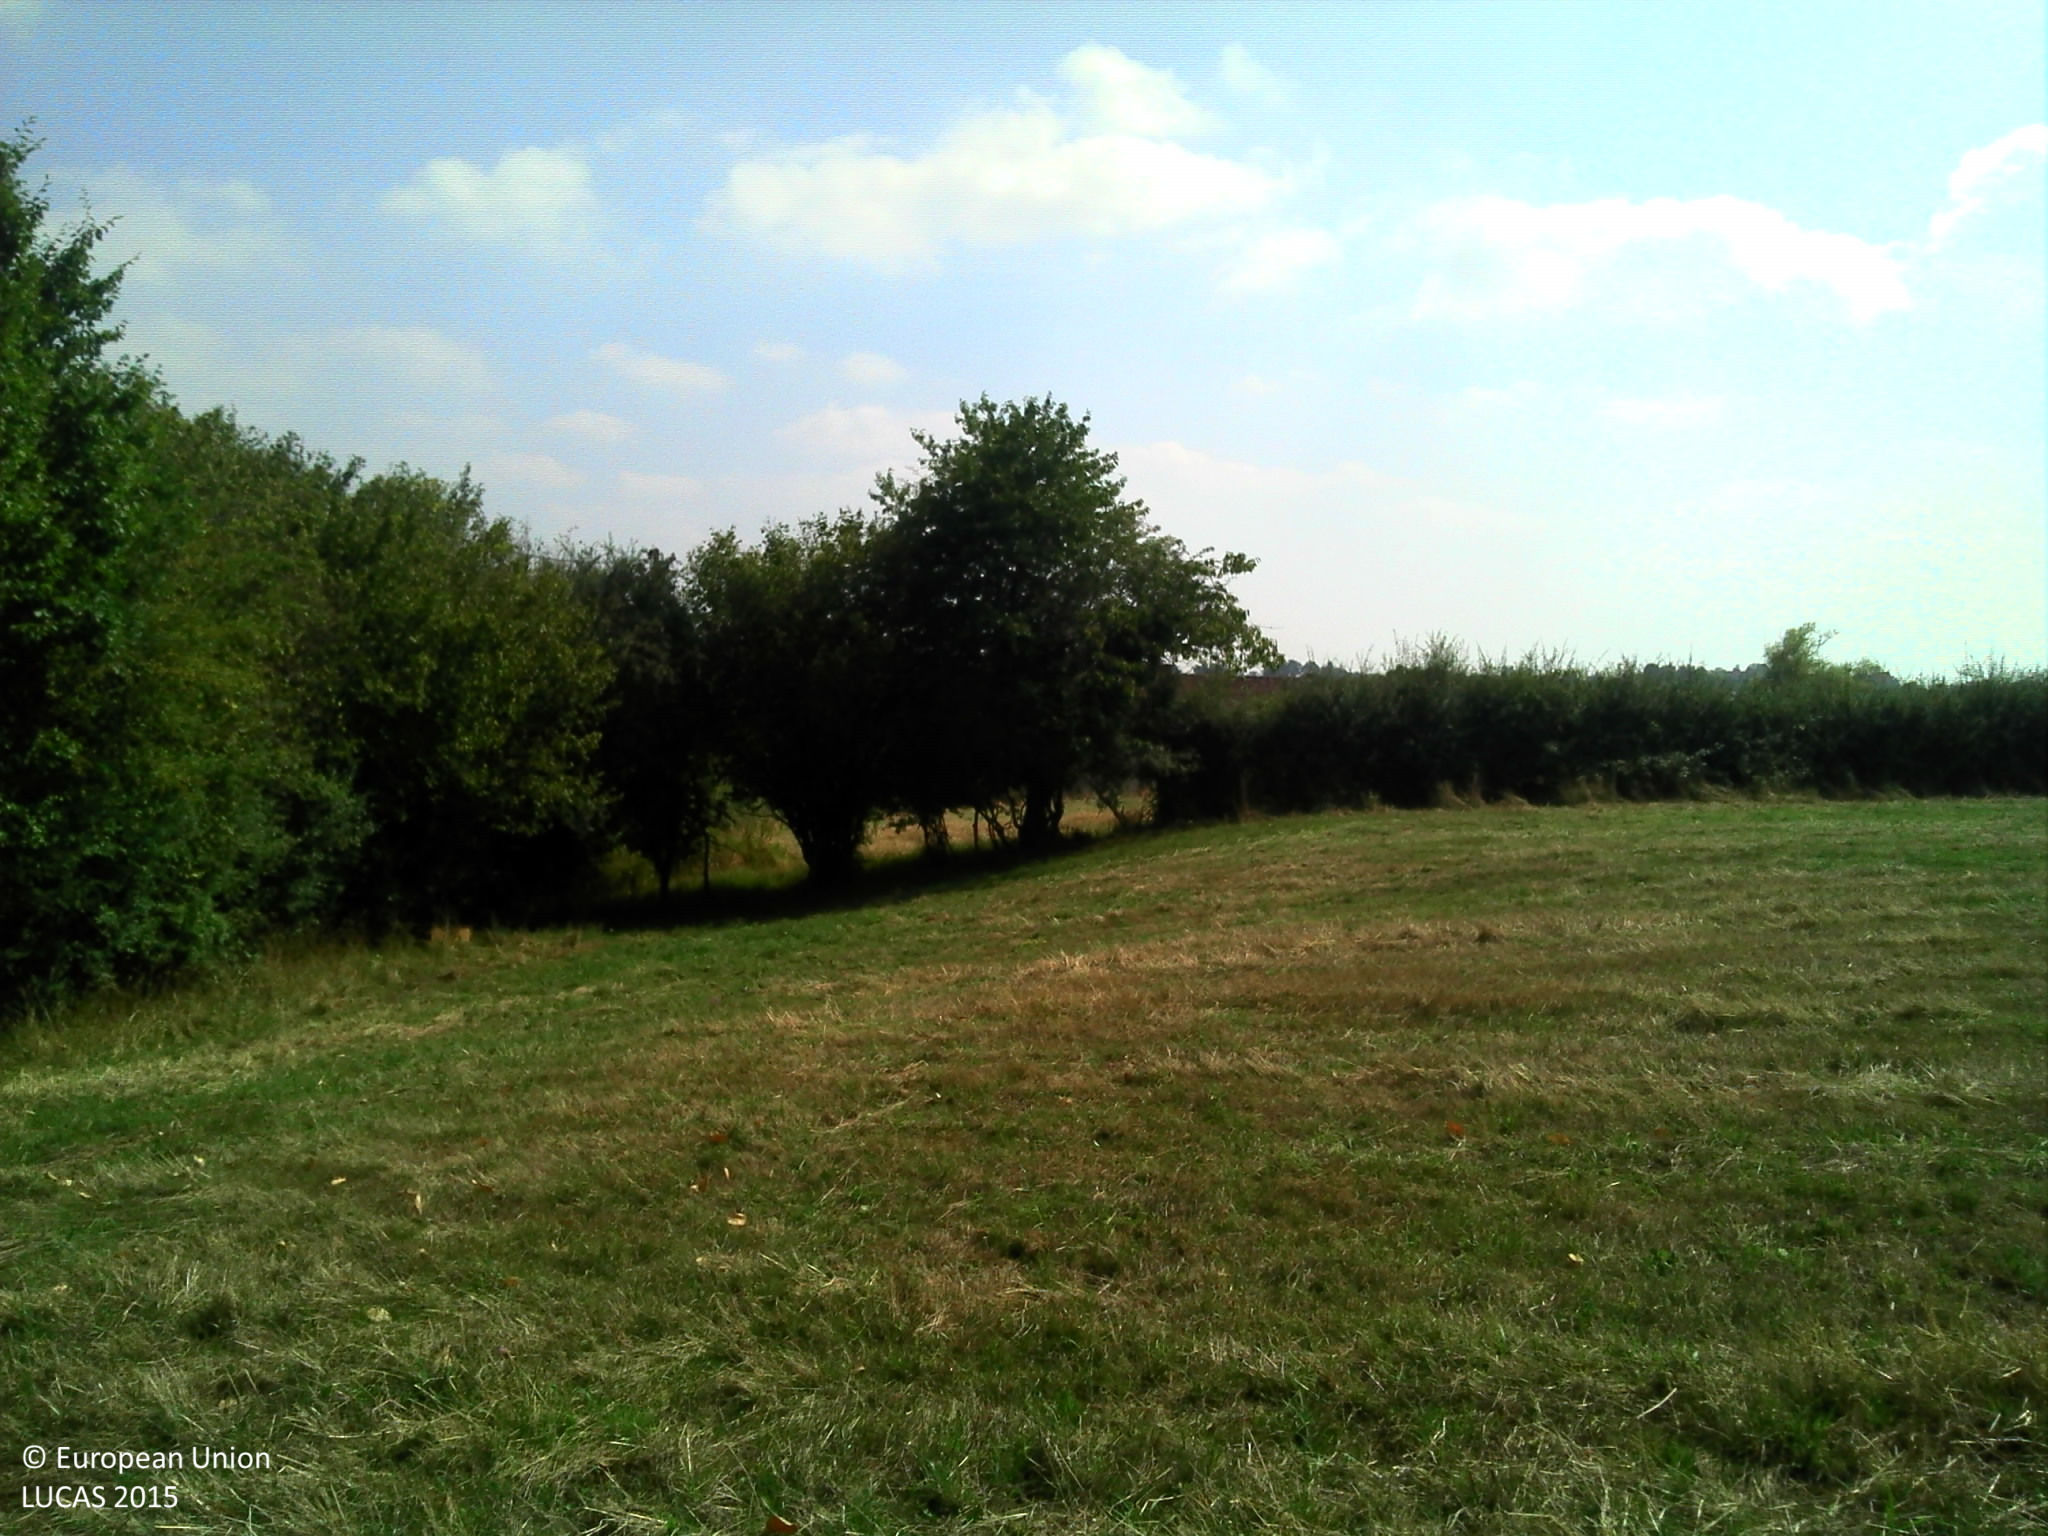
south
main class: Grassland
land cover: Grassland without tree/shrub cover
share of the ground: > 75 %
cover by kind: herbaceous plants 100 %
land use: Agriculture (excluding fallow land and kitchen gardens)
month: August
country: FR
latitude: 46.3803
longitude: 3.6678
